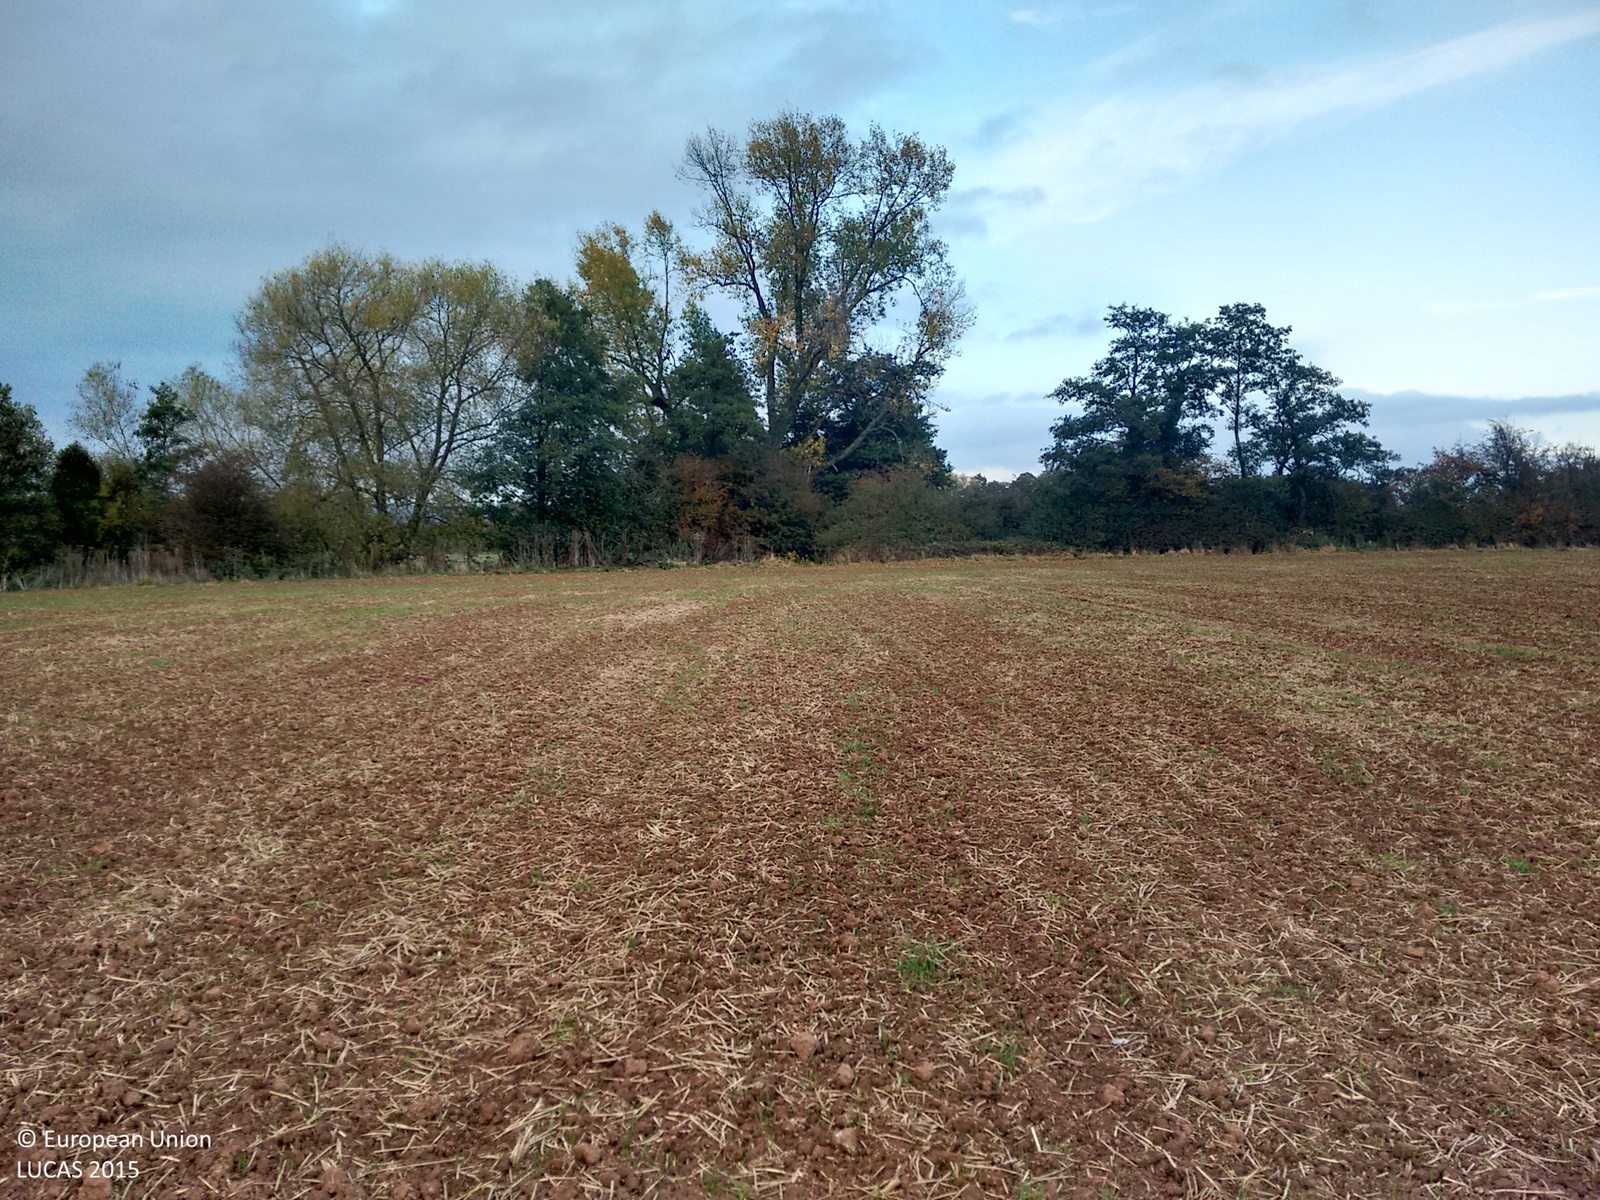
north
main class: Cropland
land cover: Oats
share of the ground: < 10 %
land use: Agriculture (excluding fallow land and kitchen gardens)
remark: Tilled/Sowed
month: October
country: GB
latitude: 52.4347
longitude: -2.7347
